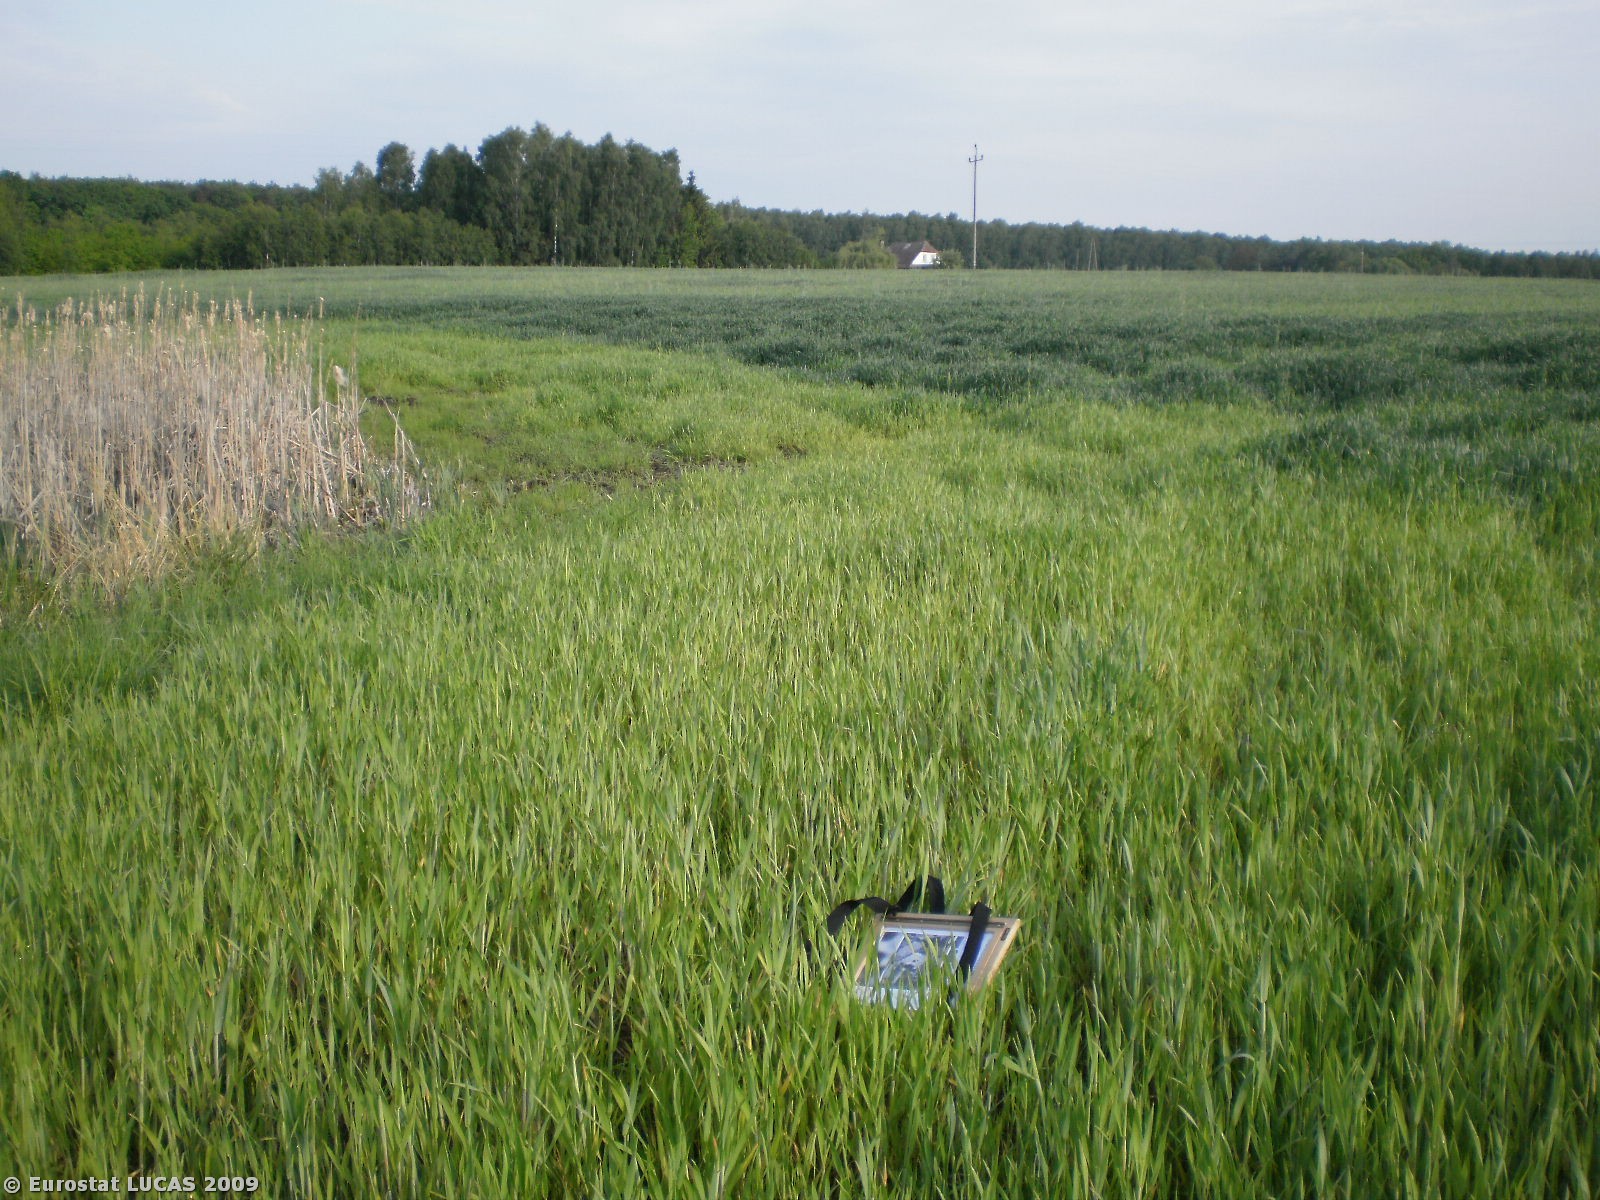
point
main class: Cropland
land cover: Triticale
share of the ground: > 75 %
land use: Agriculture (excluding fallow land and kitchen gardens)
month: May
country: PL
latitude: 53.4076
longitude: 18.2752
